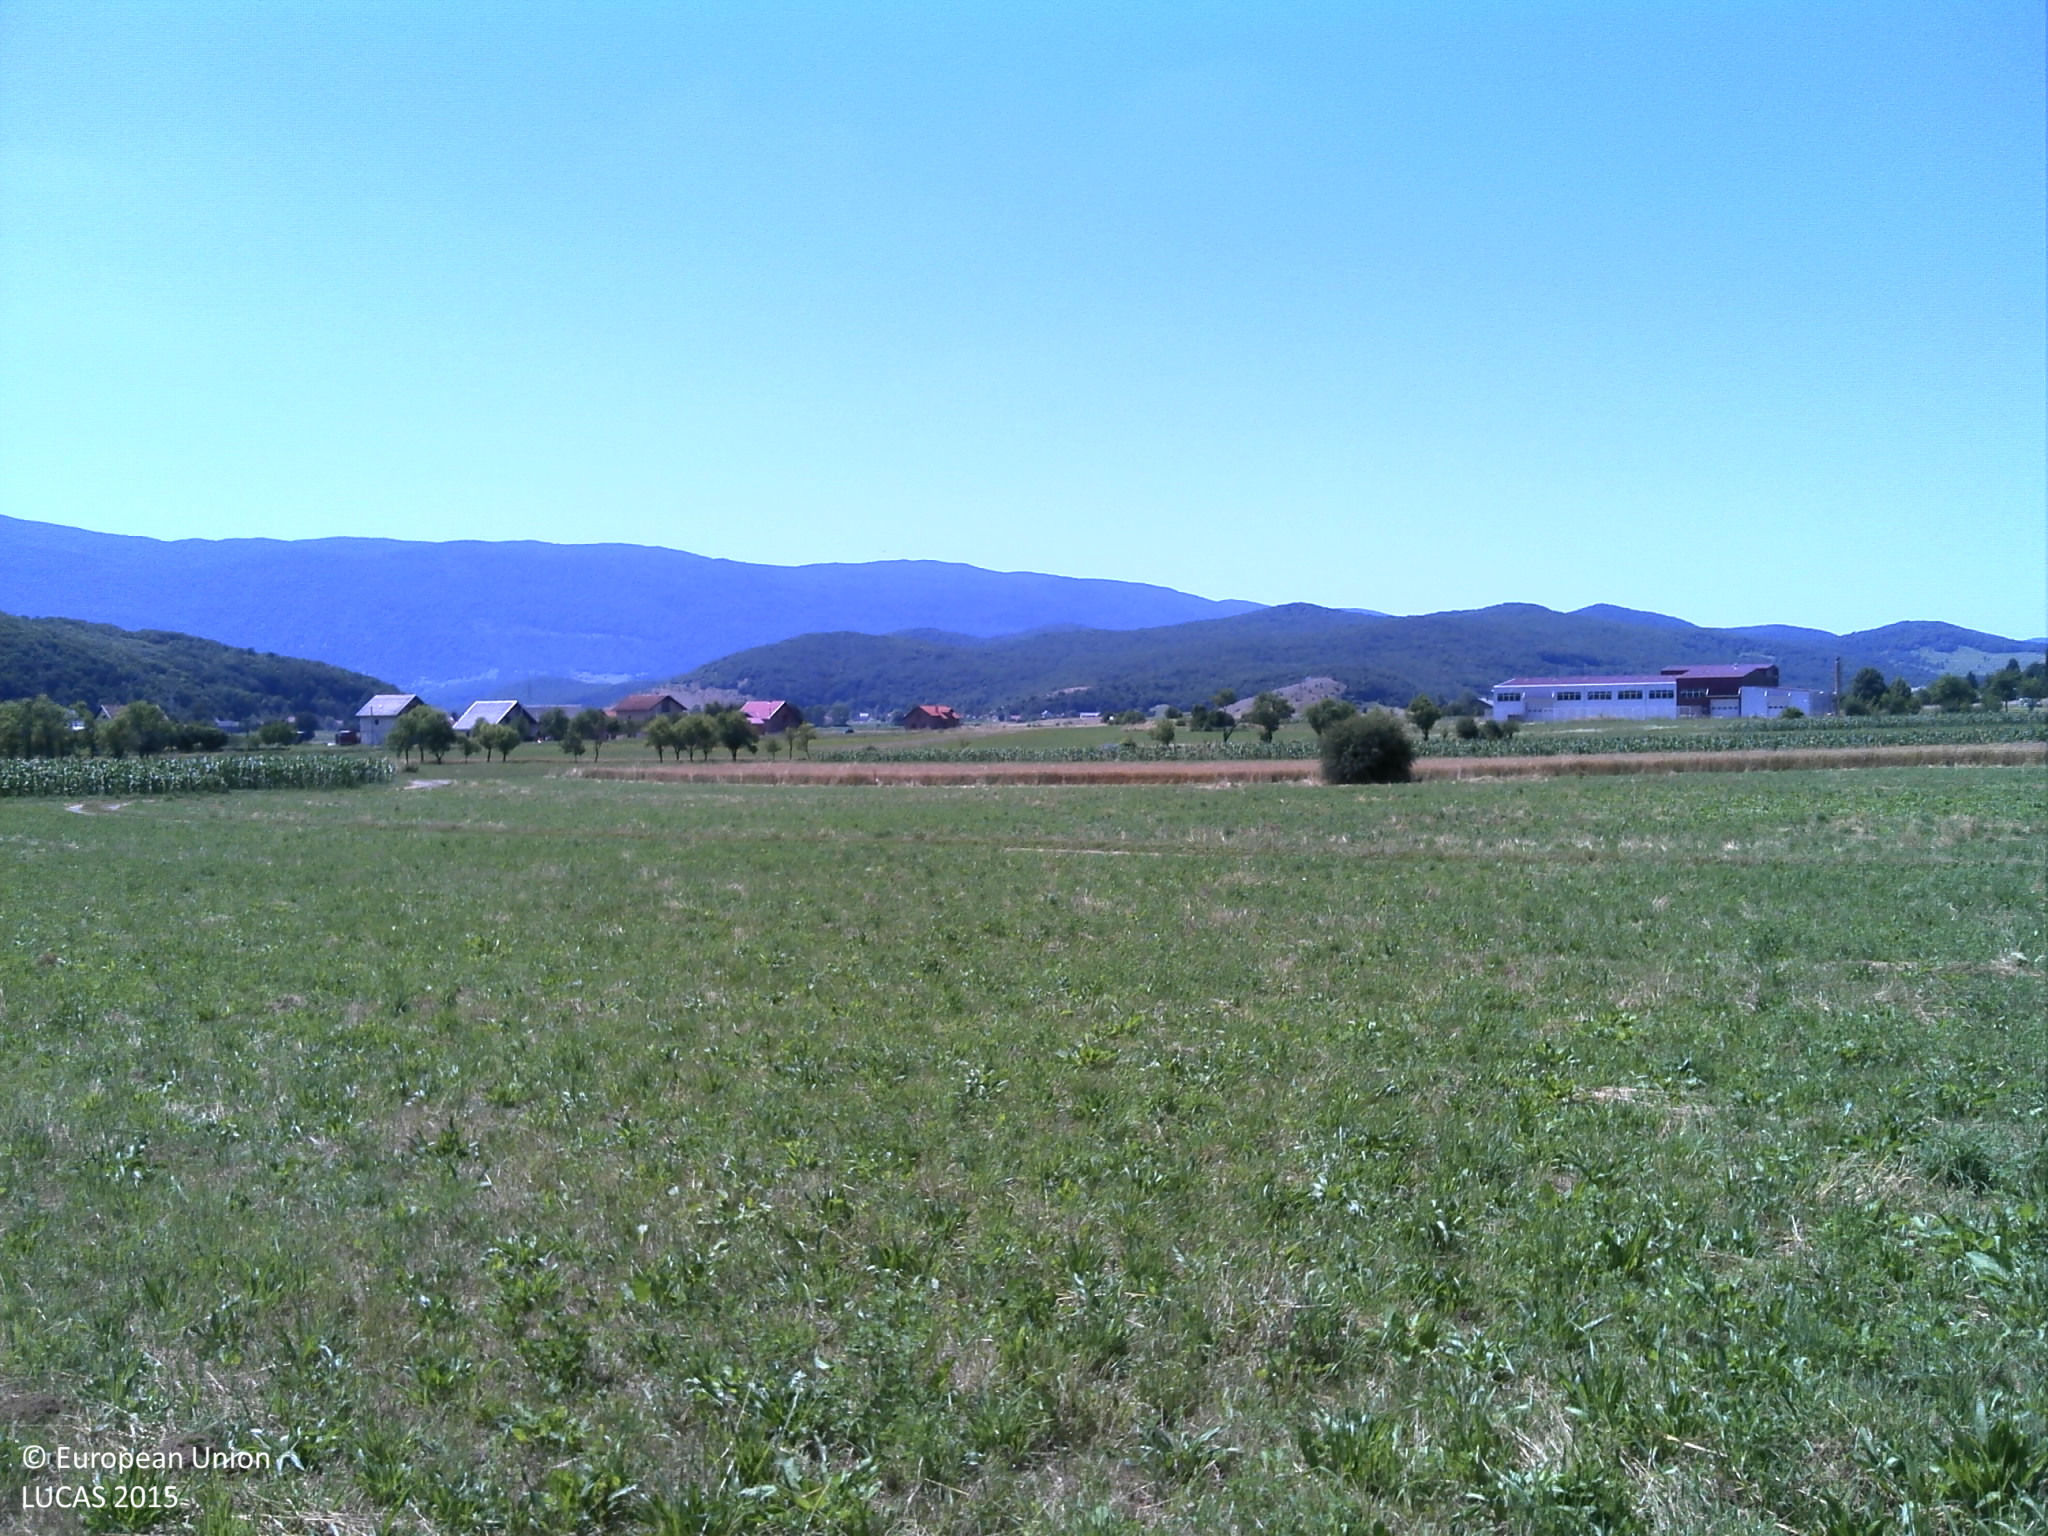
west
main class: Cropland
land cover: Temporary grasslands
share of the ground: > 75 %
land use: Agriculture (excluding fallow land and kitchen gardens)
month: July
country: HR
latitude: 44.9080
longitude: 15.1745
